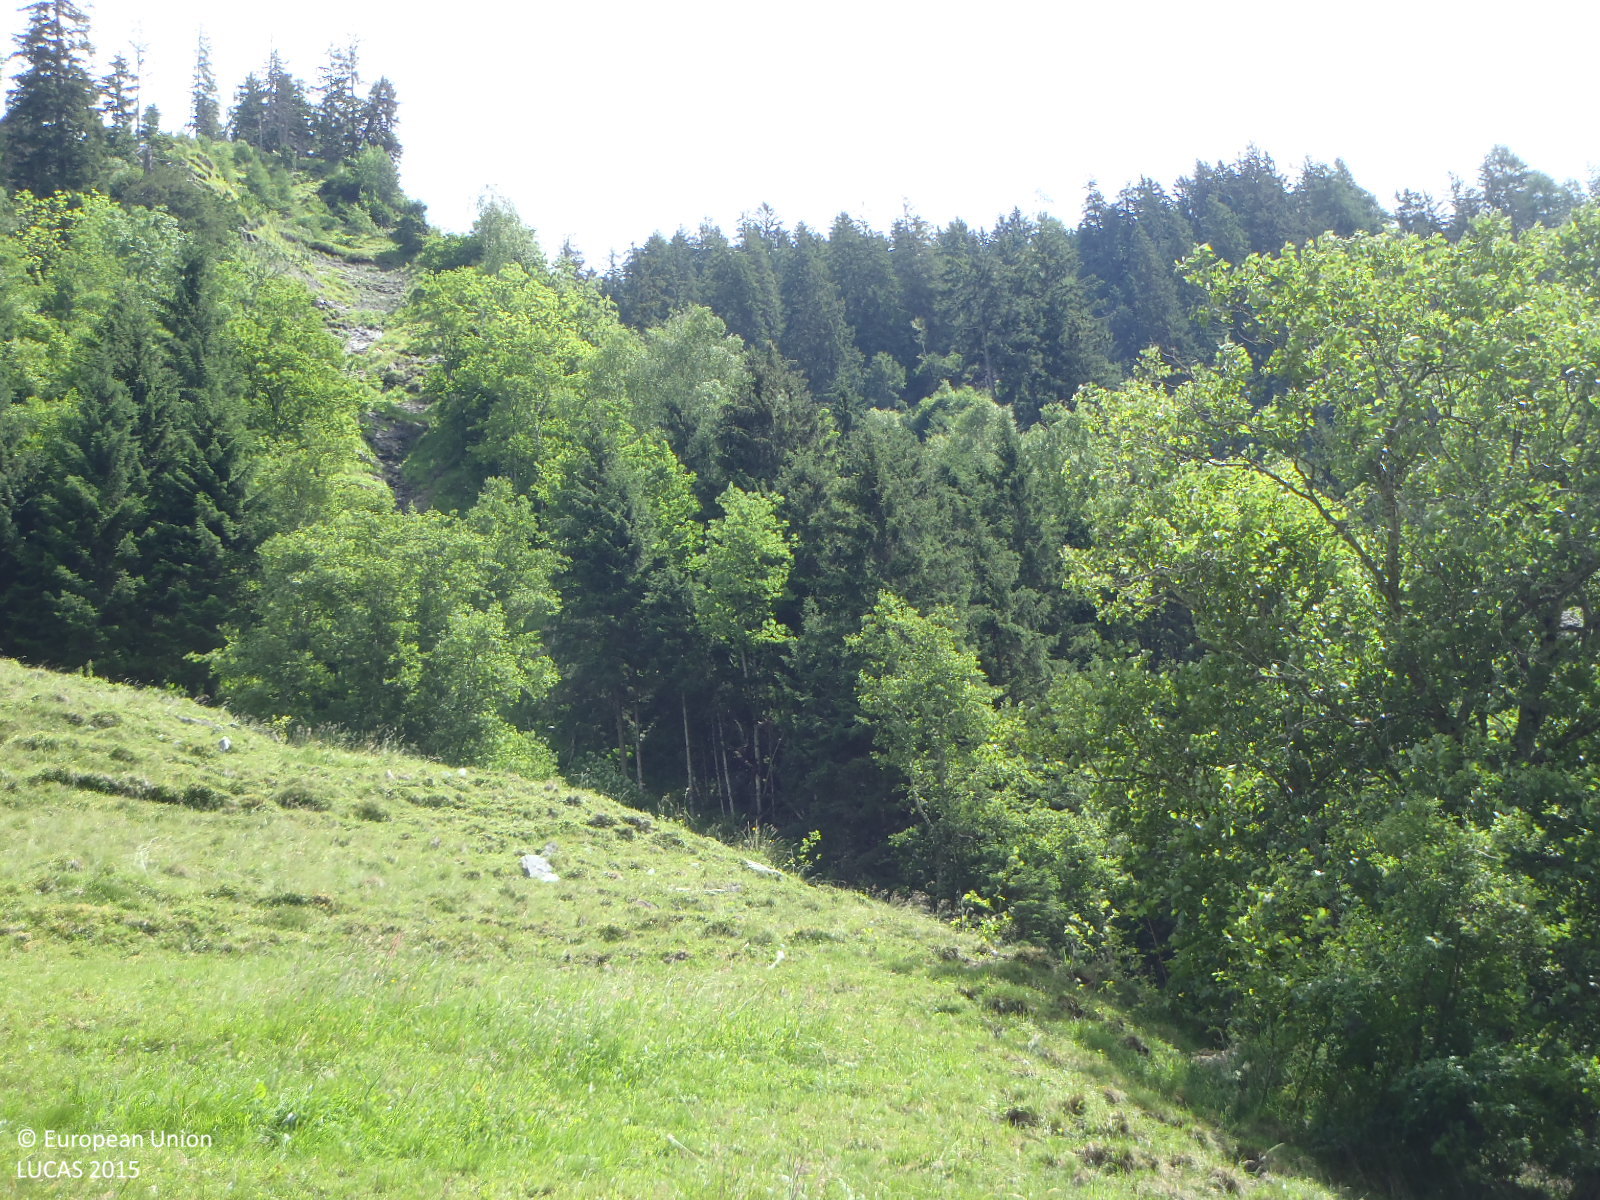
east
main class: Grassland
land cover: Grassland without tree/shrub cover
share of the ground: > 75 %
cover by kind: herbaceous plants 100 %
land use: Agriculture (excluding fallow land and kitchen gardens)
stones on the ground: < 10 %
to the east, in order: Grassland without tree/shrub cover; Shrubland without tree cover; Spruce dominated mixed woodland; Broadleaved woodland; Rocks and stones; Grassland with sparse tree/shrub cover; Rocks and stones; Grassland with sparse tree/shrub cover
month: June
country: AT
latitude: 47.2409
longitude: 12.4949
